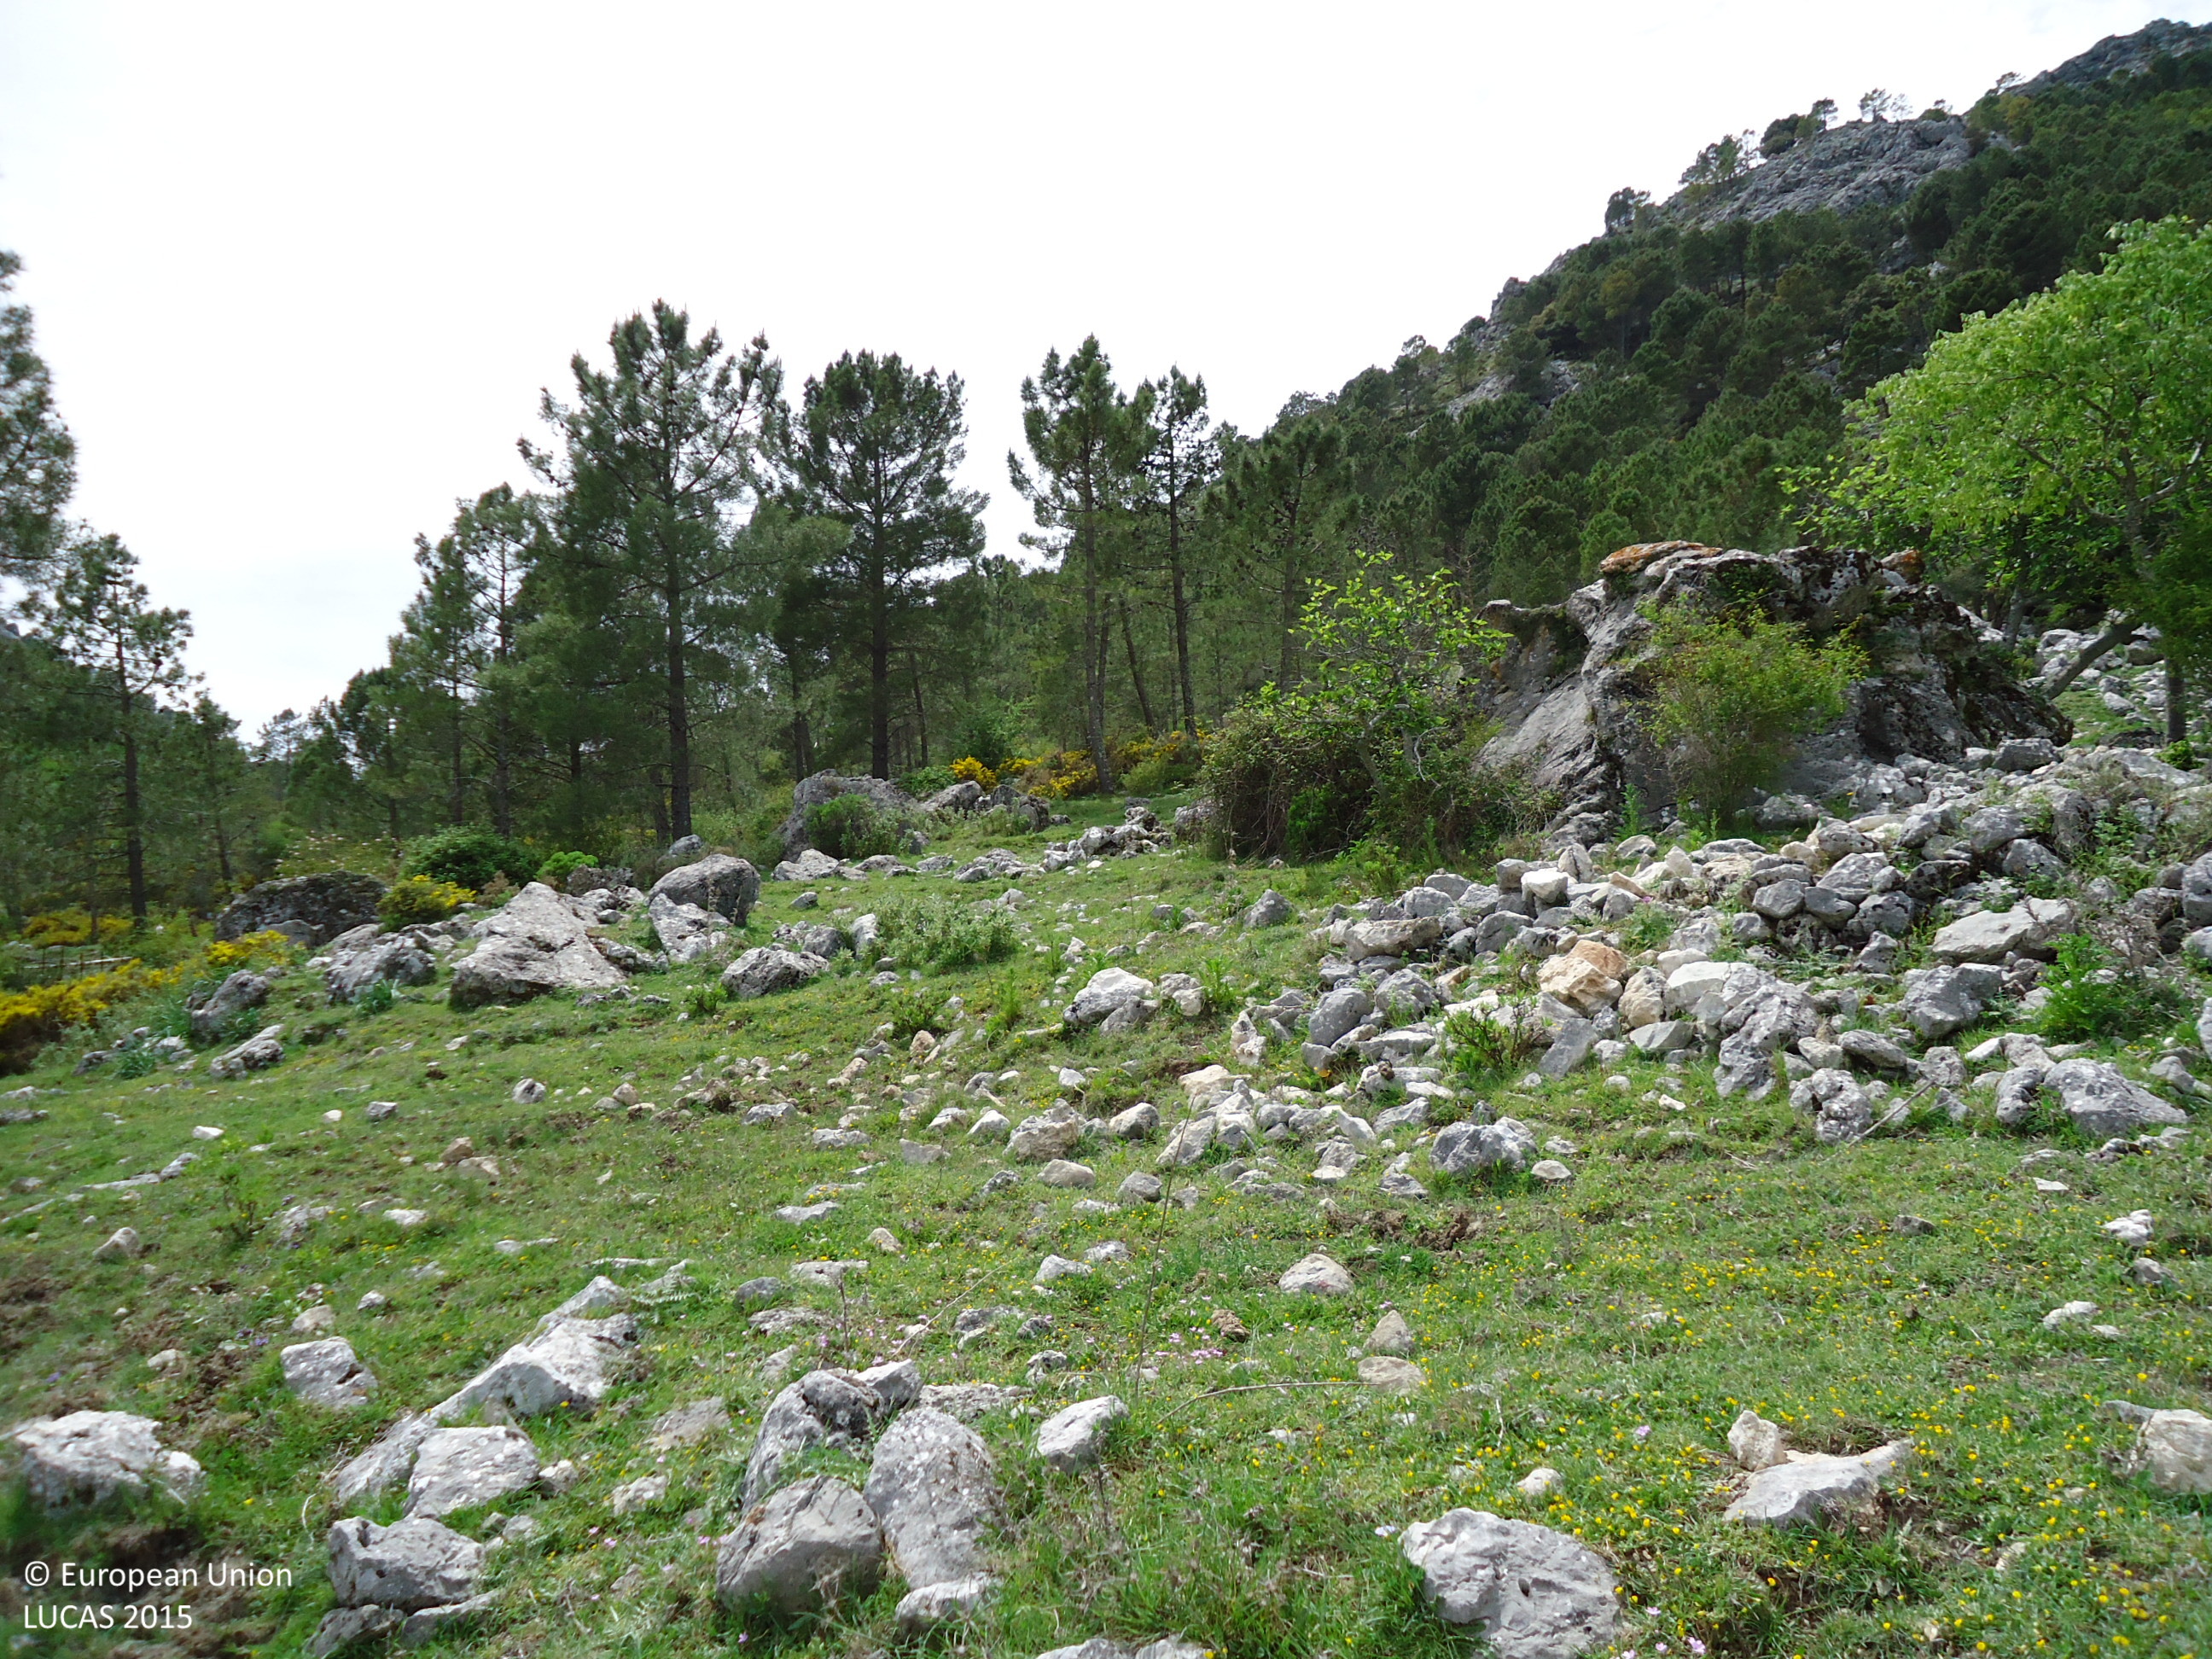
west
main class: Grassland
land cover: Grassland with sparse tree/shrub cover
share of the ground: > 75 %
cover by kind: herbaceous plants 85 %, consolidated bare surface 10 %, coniferous forest trees 5 %
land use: Agriculture (excluding fallow land and kitchen gardens)
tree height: > 5 m
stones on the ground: 10 - 25 %
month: May
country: ES
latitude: 36.7640
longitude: -5.3836
